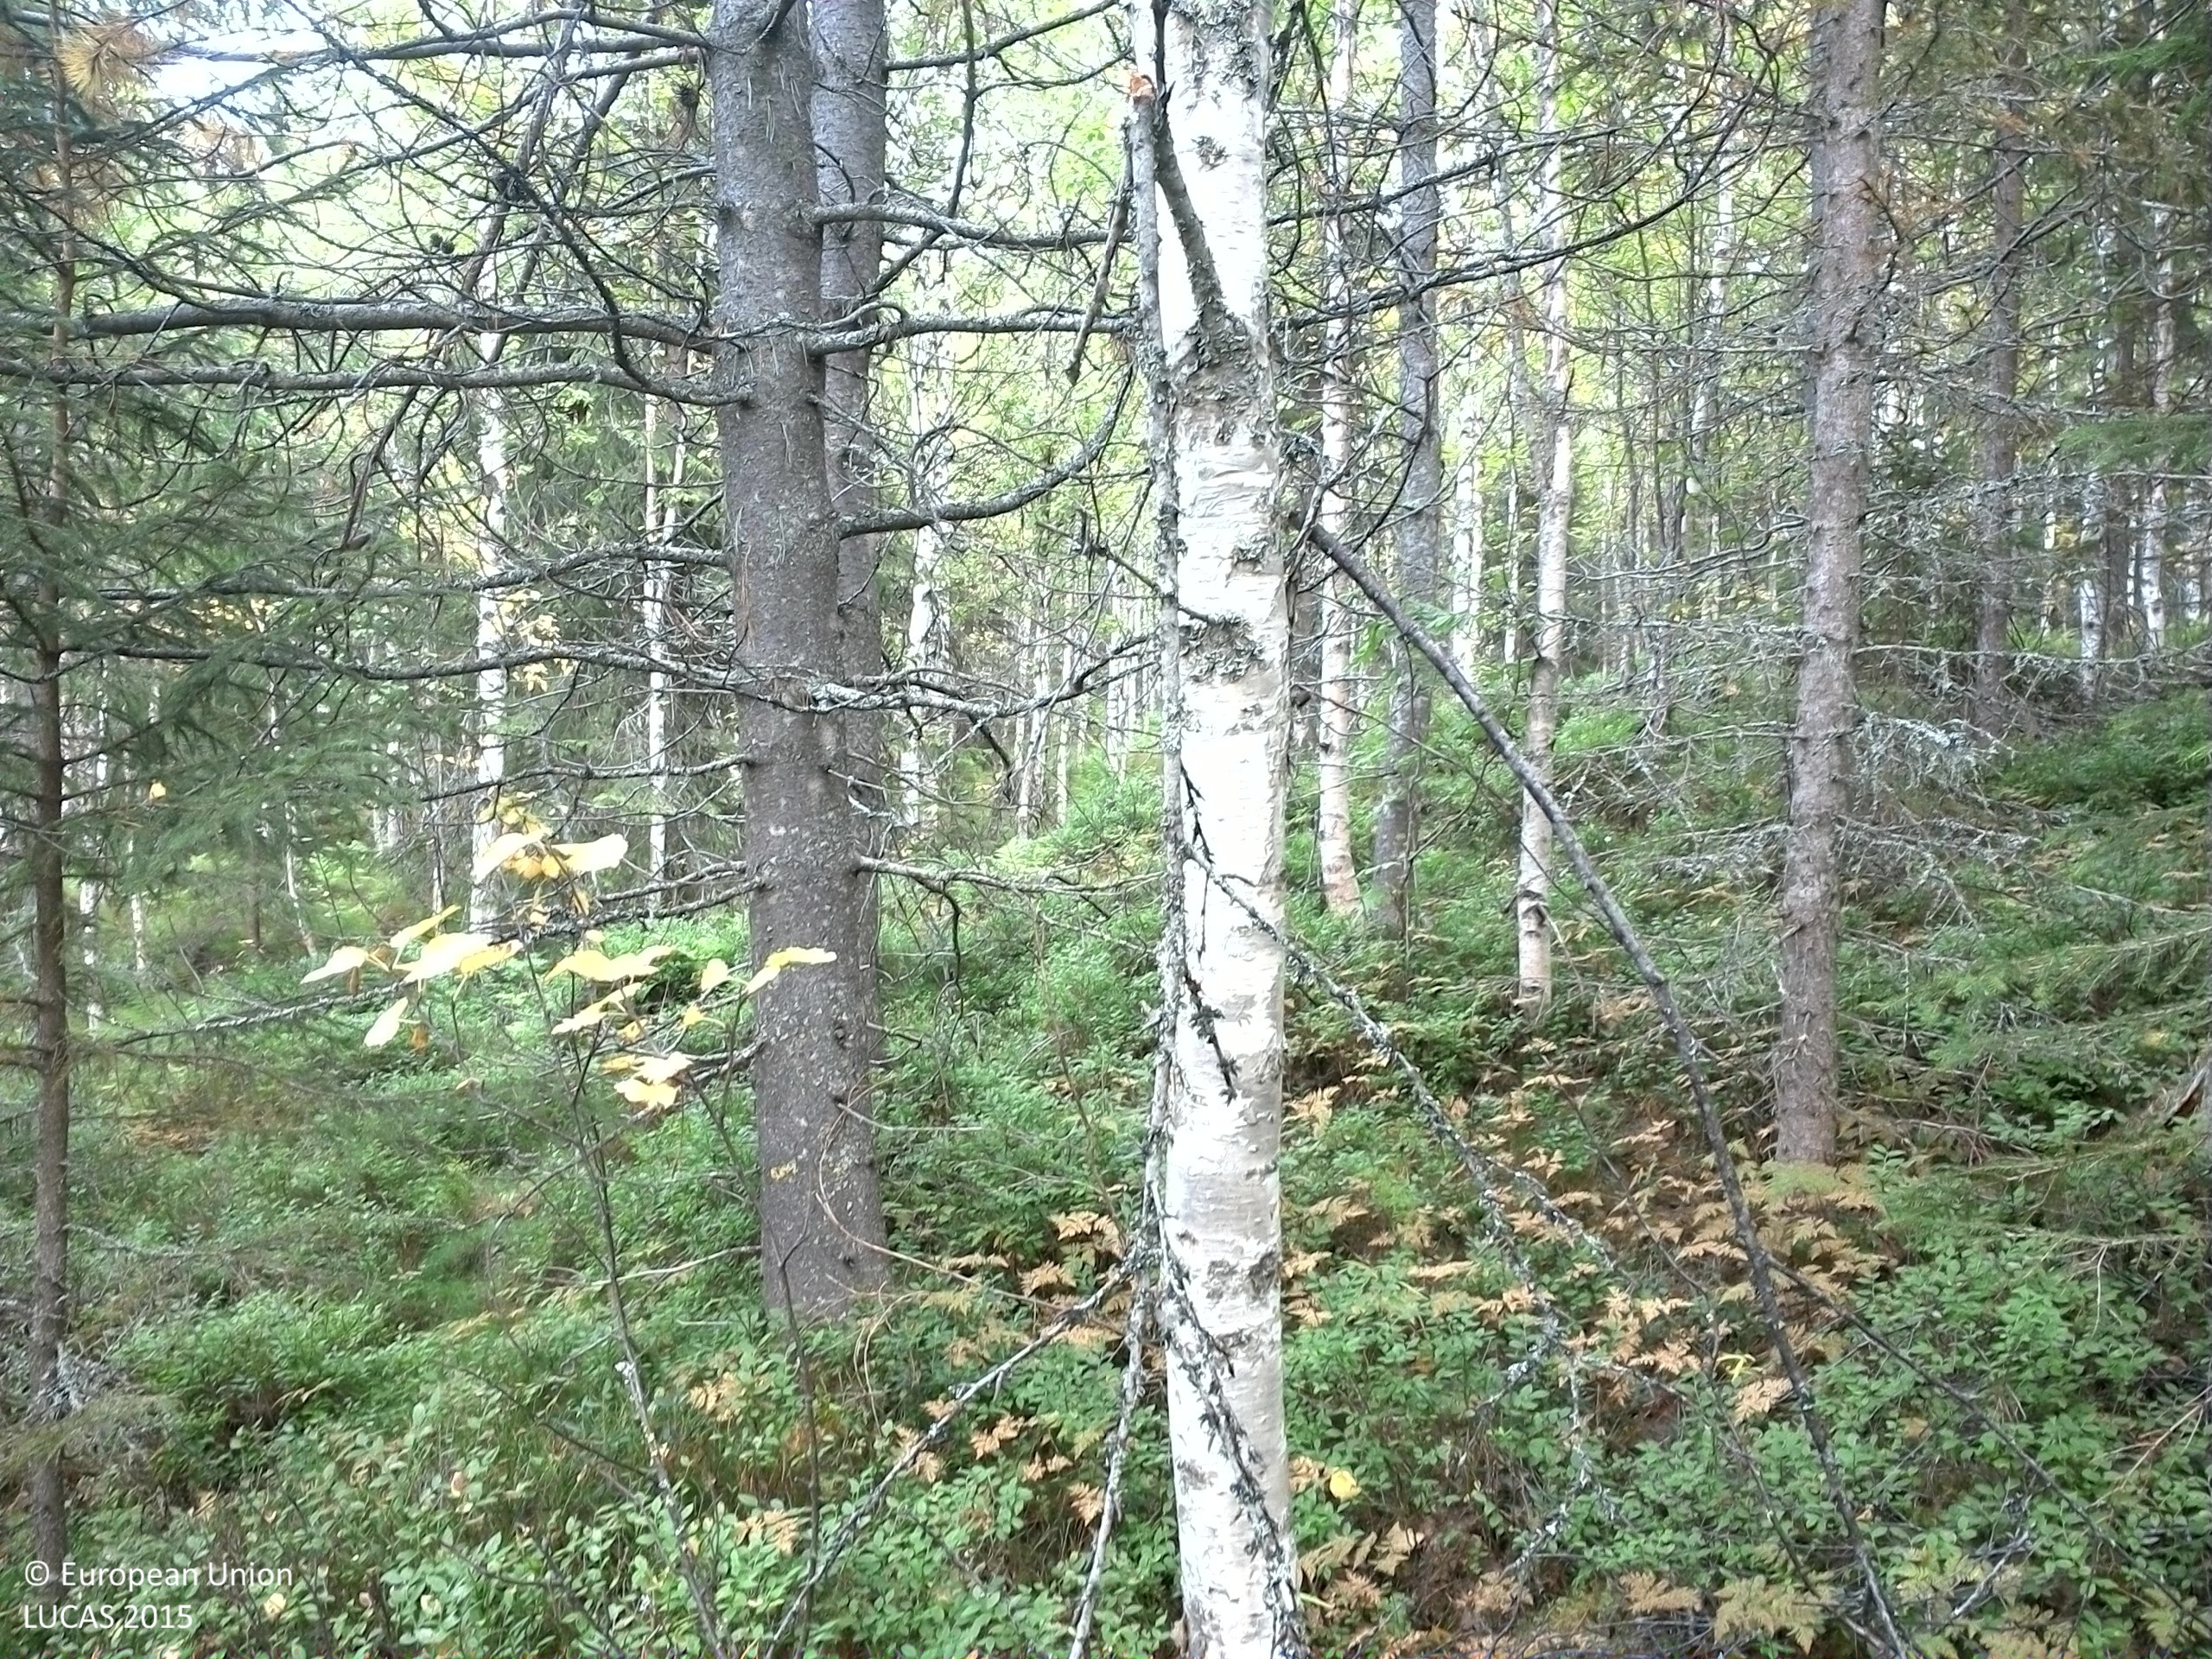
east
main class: Woodland
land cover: Other mixed woodland
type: boreal forest
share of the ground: 50 - 75 %
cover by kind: coniferous forest trees 35 %, broadleaved forest trees 35 %, shrubs 25 %, lichens and mosses 5 %
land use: Forestry
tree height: > 5 m
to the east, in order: Other mixed woodland; Spruce dominated mixed woodland; Rivers and streams; Spruce dominated mixed woodland; Broadleaved woodland
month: September
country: SE
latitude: 64.0209
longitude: 16.7023
